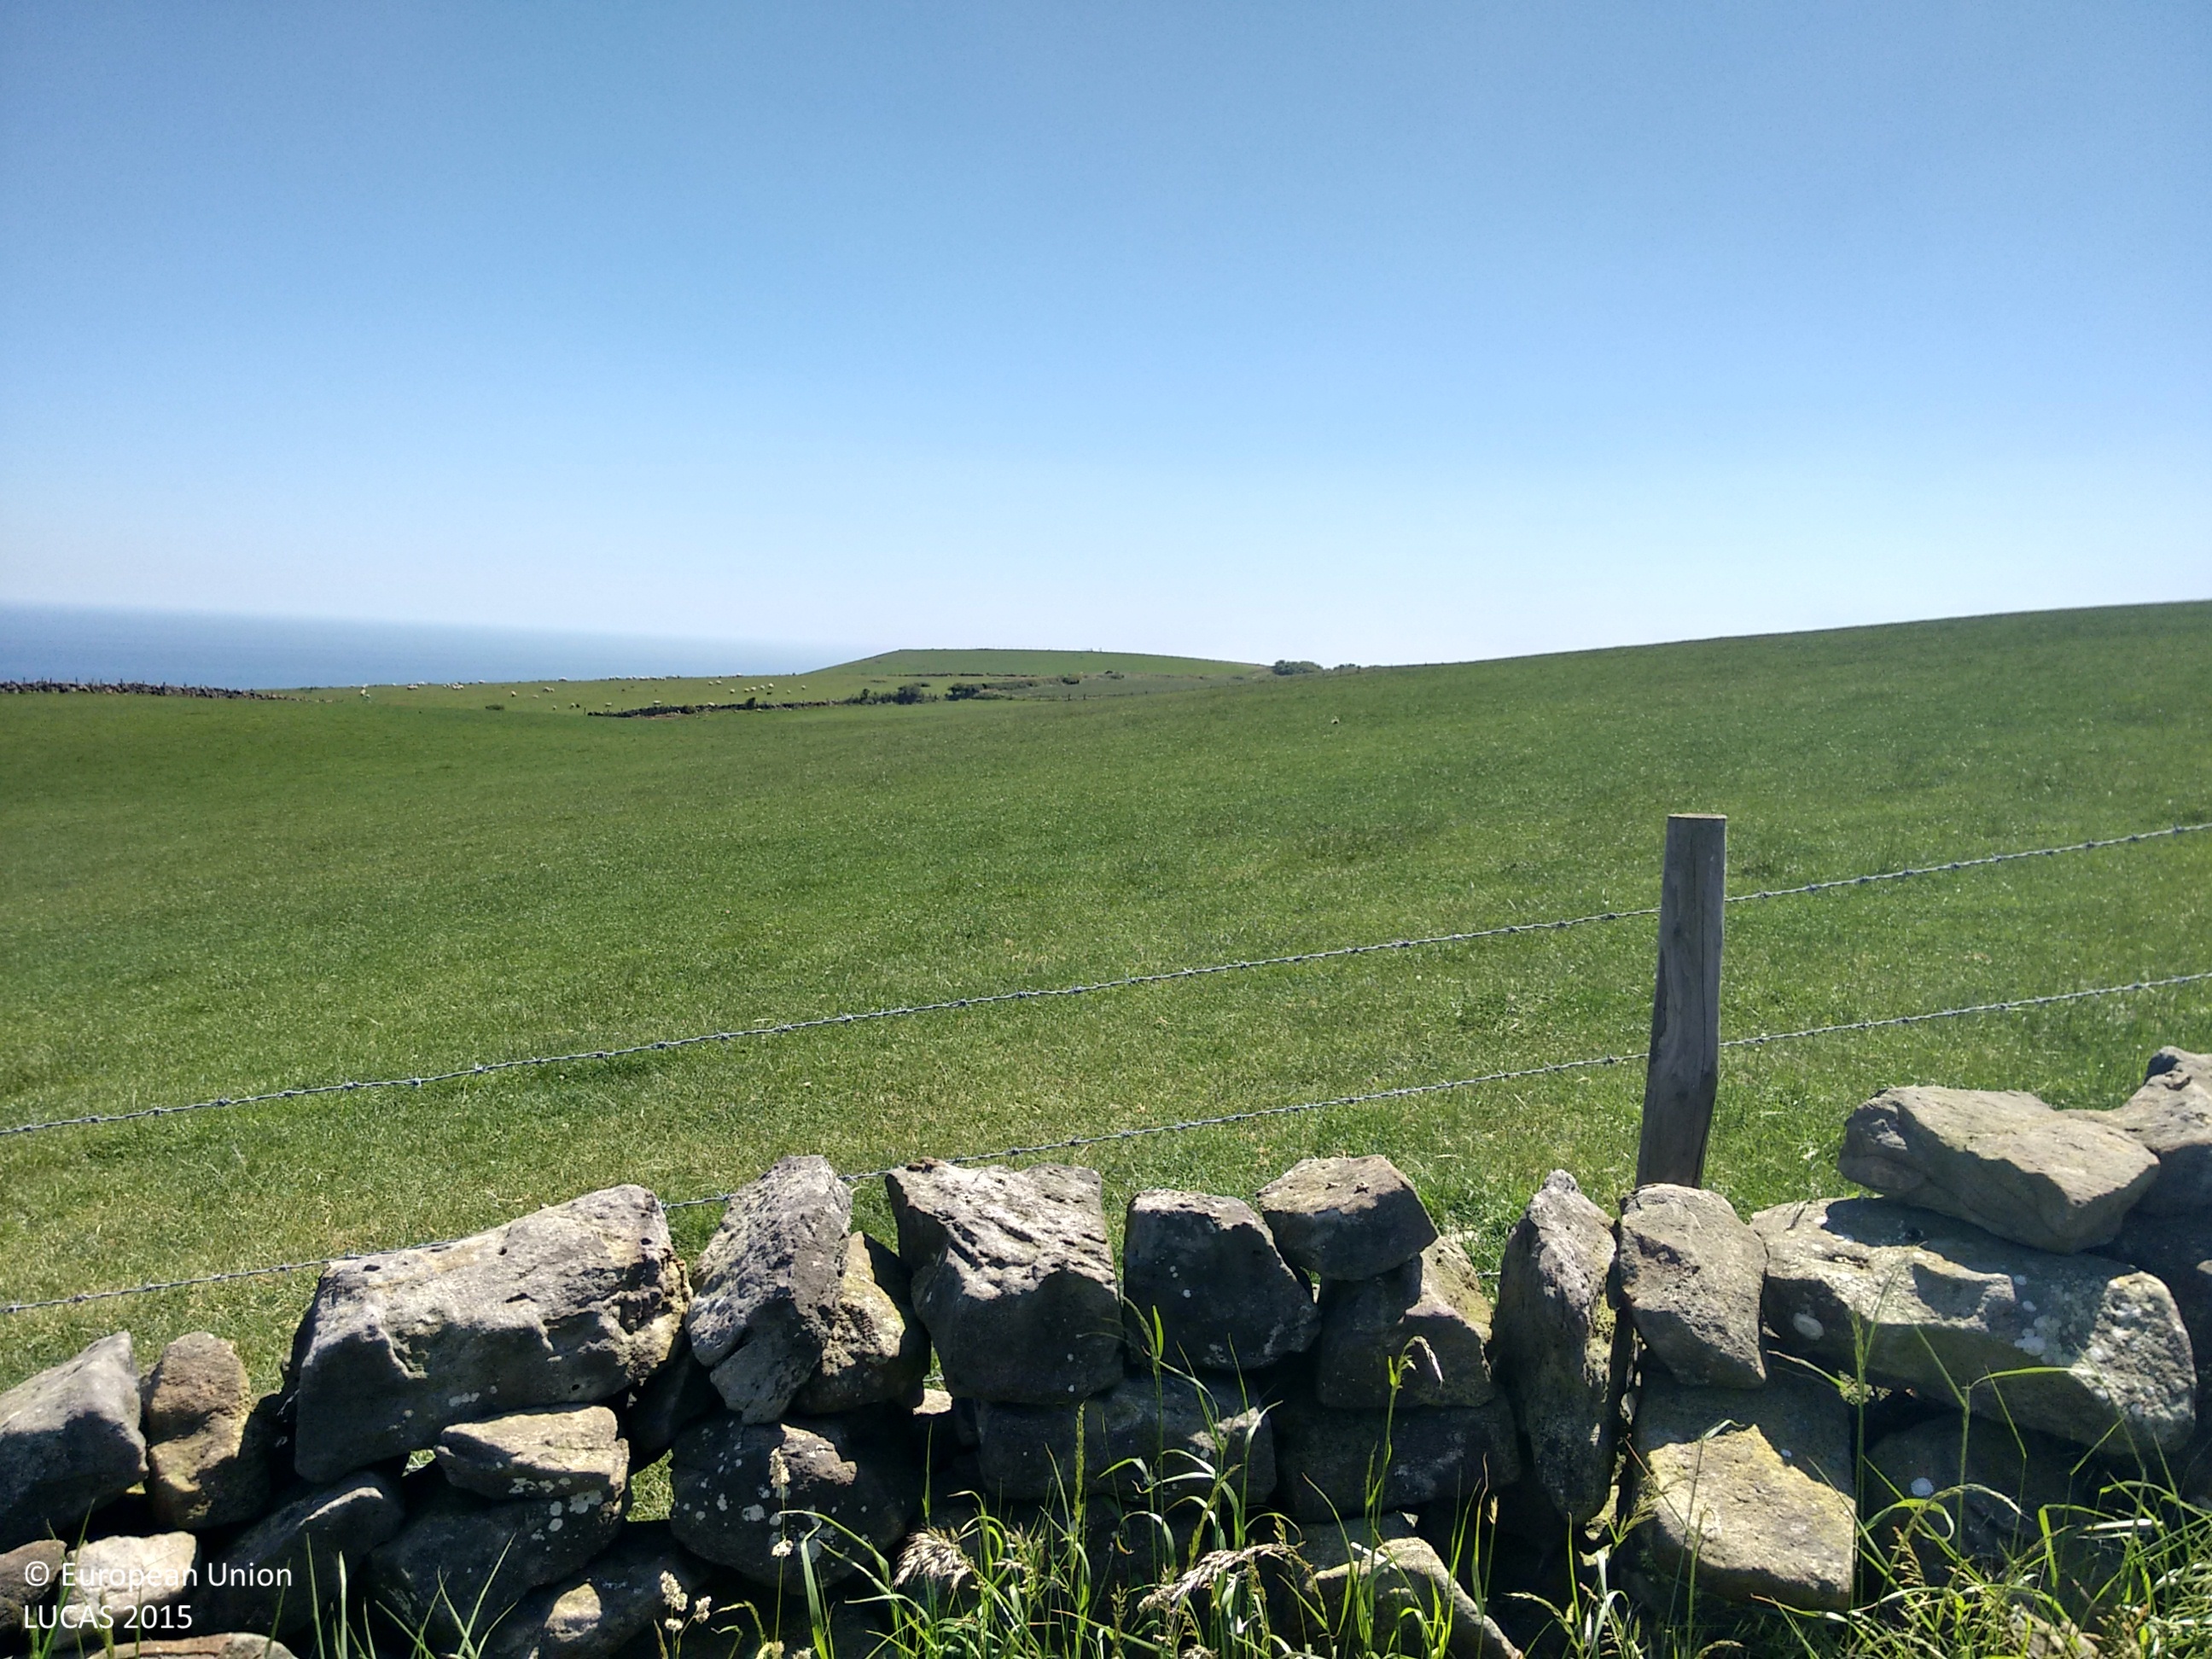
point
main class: Grassland
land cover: Grassland without tree/shrub cover
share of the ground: > 75 %
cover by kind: herbaceous plants 100 %
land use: Agriculture (excluding fallow land and kitchen gardens)
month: June
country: GB
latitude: 54.4463
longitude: -0.5380
